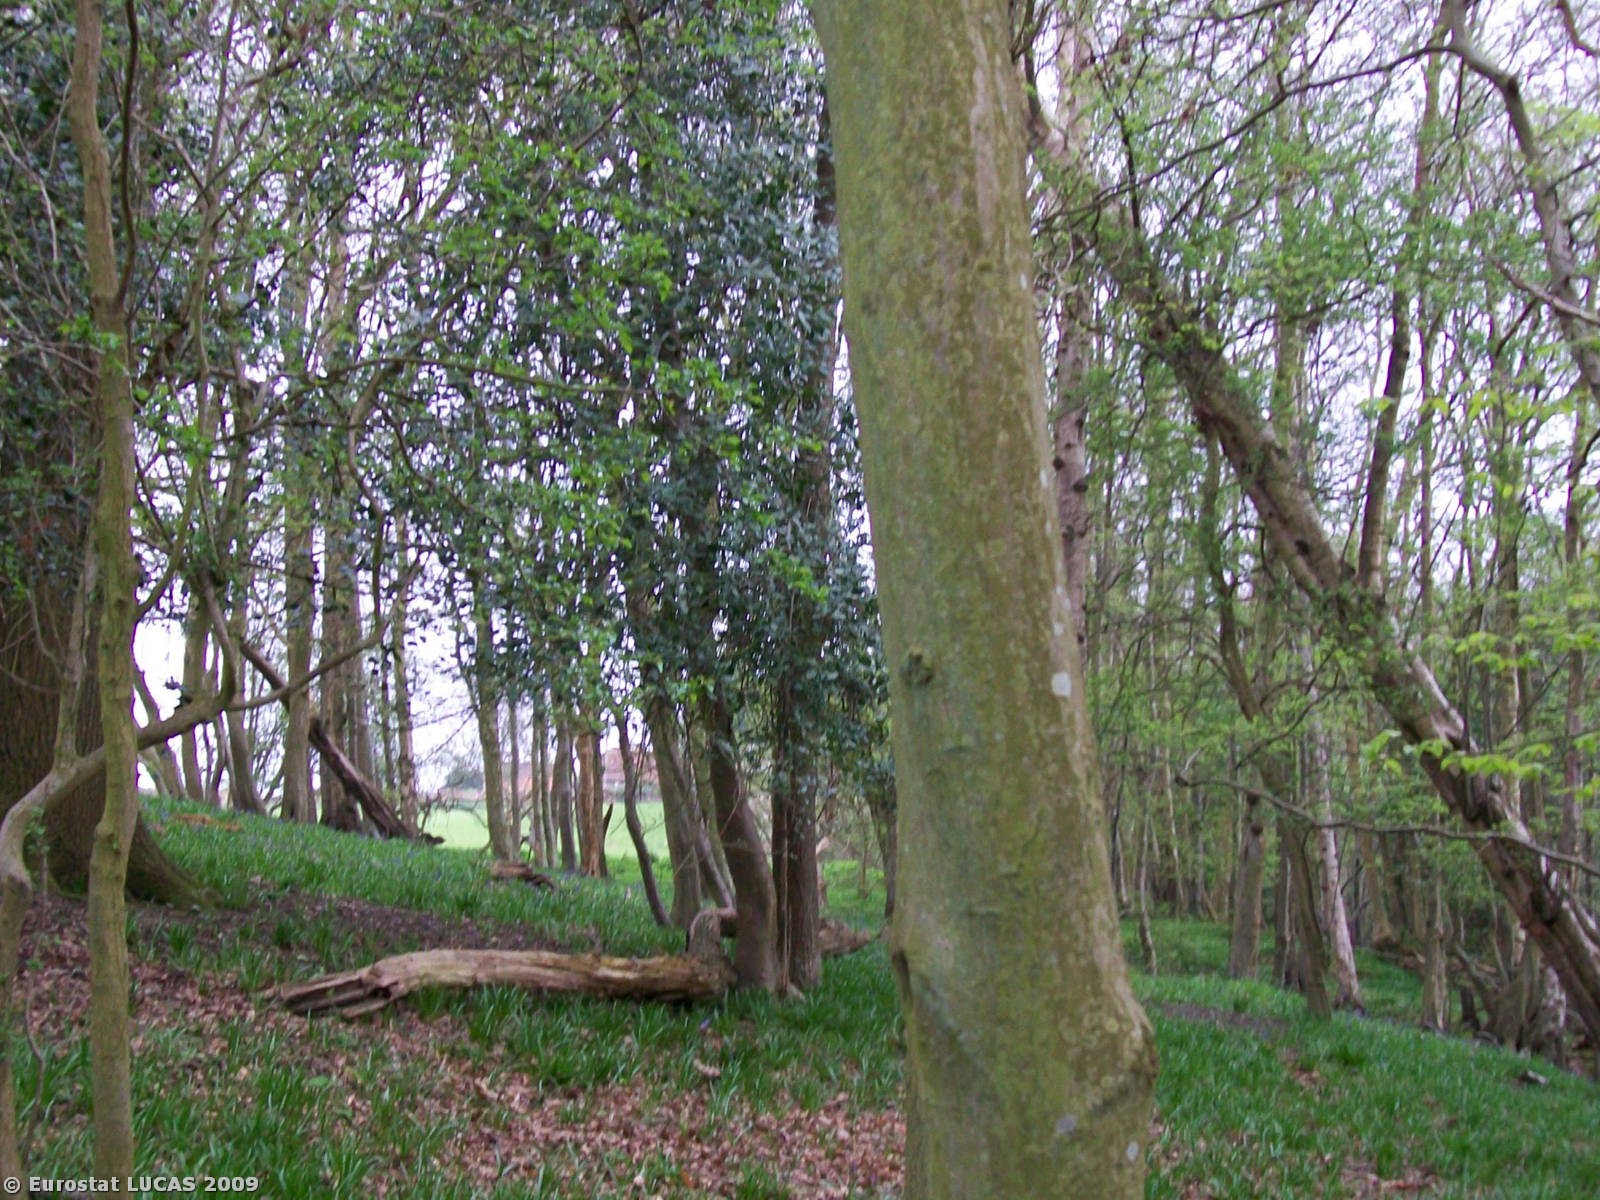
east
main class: Woodland
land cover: Mixed woodland
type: mesophytic deciduous forest
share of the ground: > 75 %
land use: Forestry
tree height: > 5 m
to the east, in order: Mixed woodland; Grassland without tree/shrub cover; Managed hedges; Paved roads, cycling and walking lanes; Managed hedges; Grassland without tree/shrub cover; Managed hedges; Temporary grasslands; Managed hedges; Grassland without tree/shrub cover
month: April
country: GB
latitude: 50.9523
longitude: 0.3622
